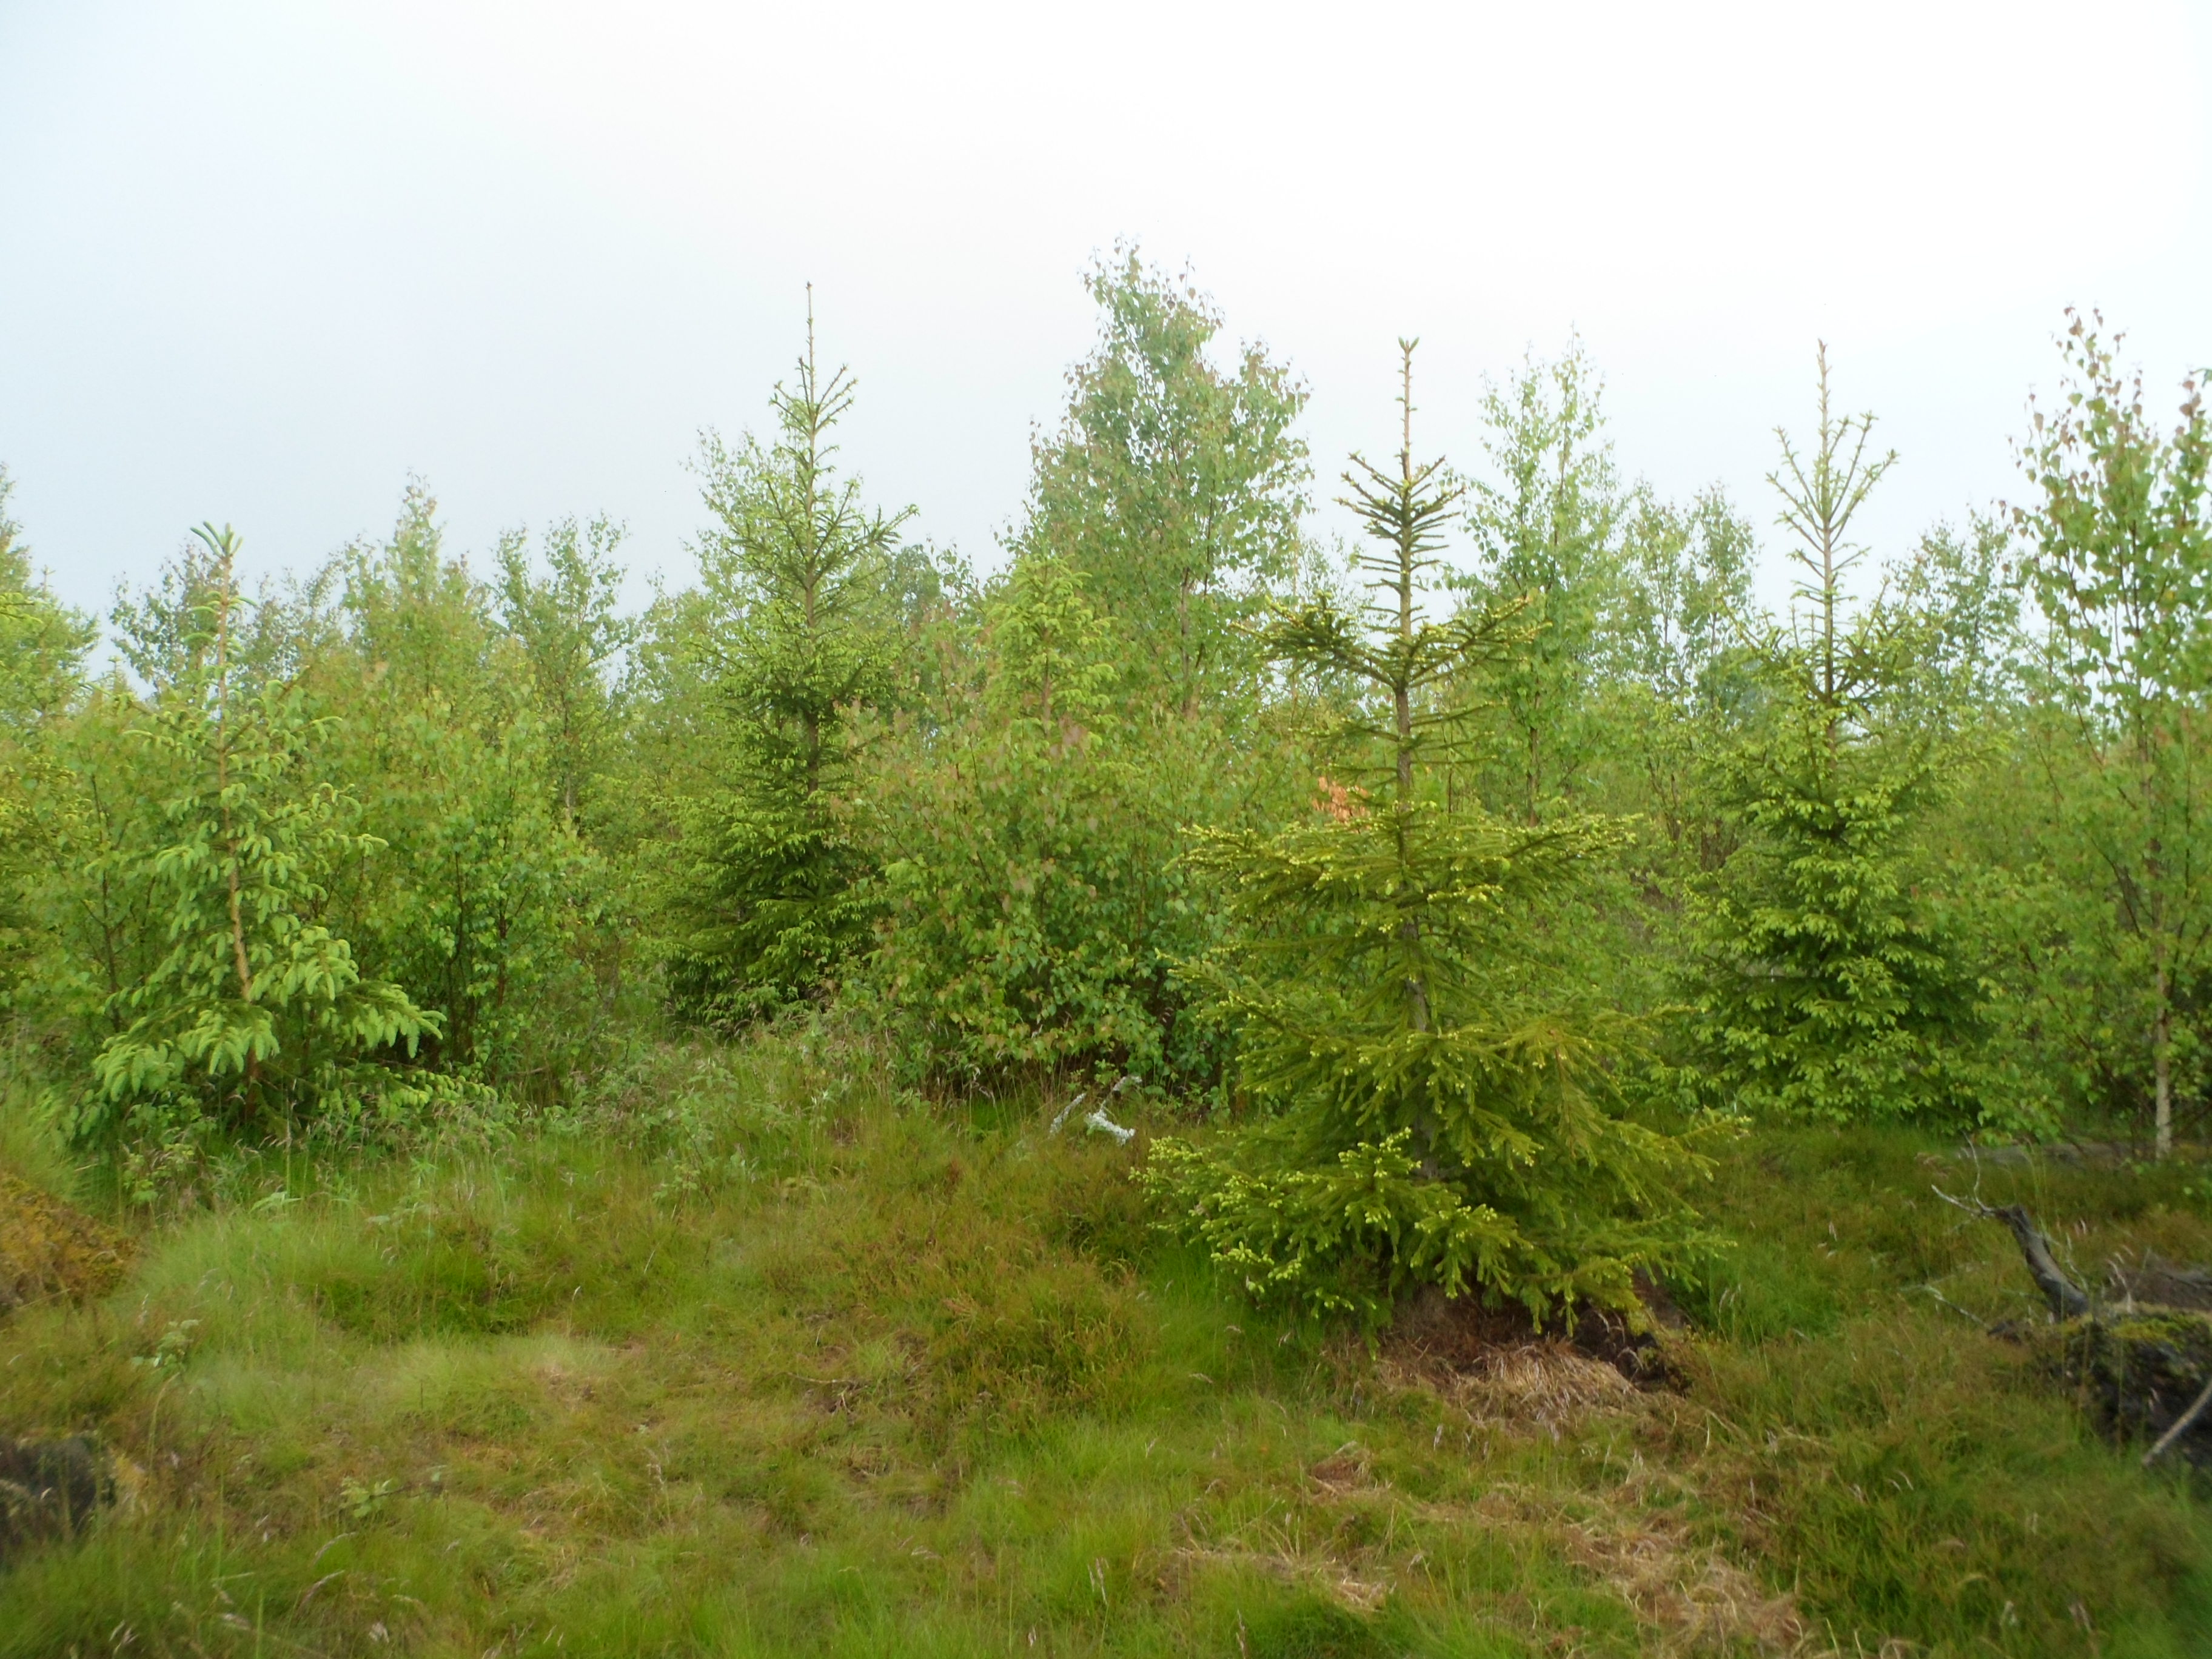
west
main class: Woodland
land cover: Spruce dominated mixed woodland
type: boreal forest
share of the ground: 50 - 75 %
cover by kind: broadleaved forest trees 35 %, coniferous forest trees 25 %, shrubs 20 %, herbaceous plants 15 %, lichens and mosses 5 %
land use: Forestry
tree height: < 5 m
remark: Clear cut
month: June
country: SE
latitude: 56.8874
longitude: 14.3790
